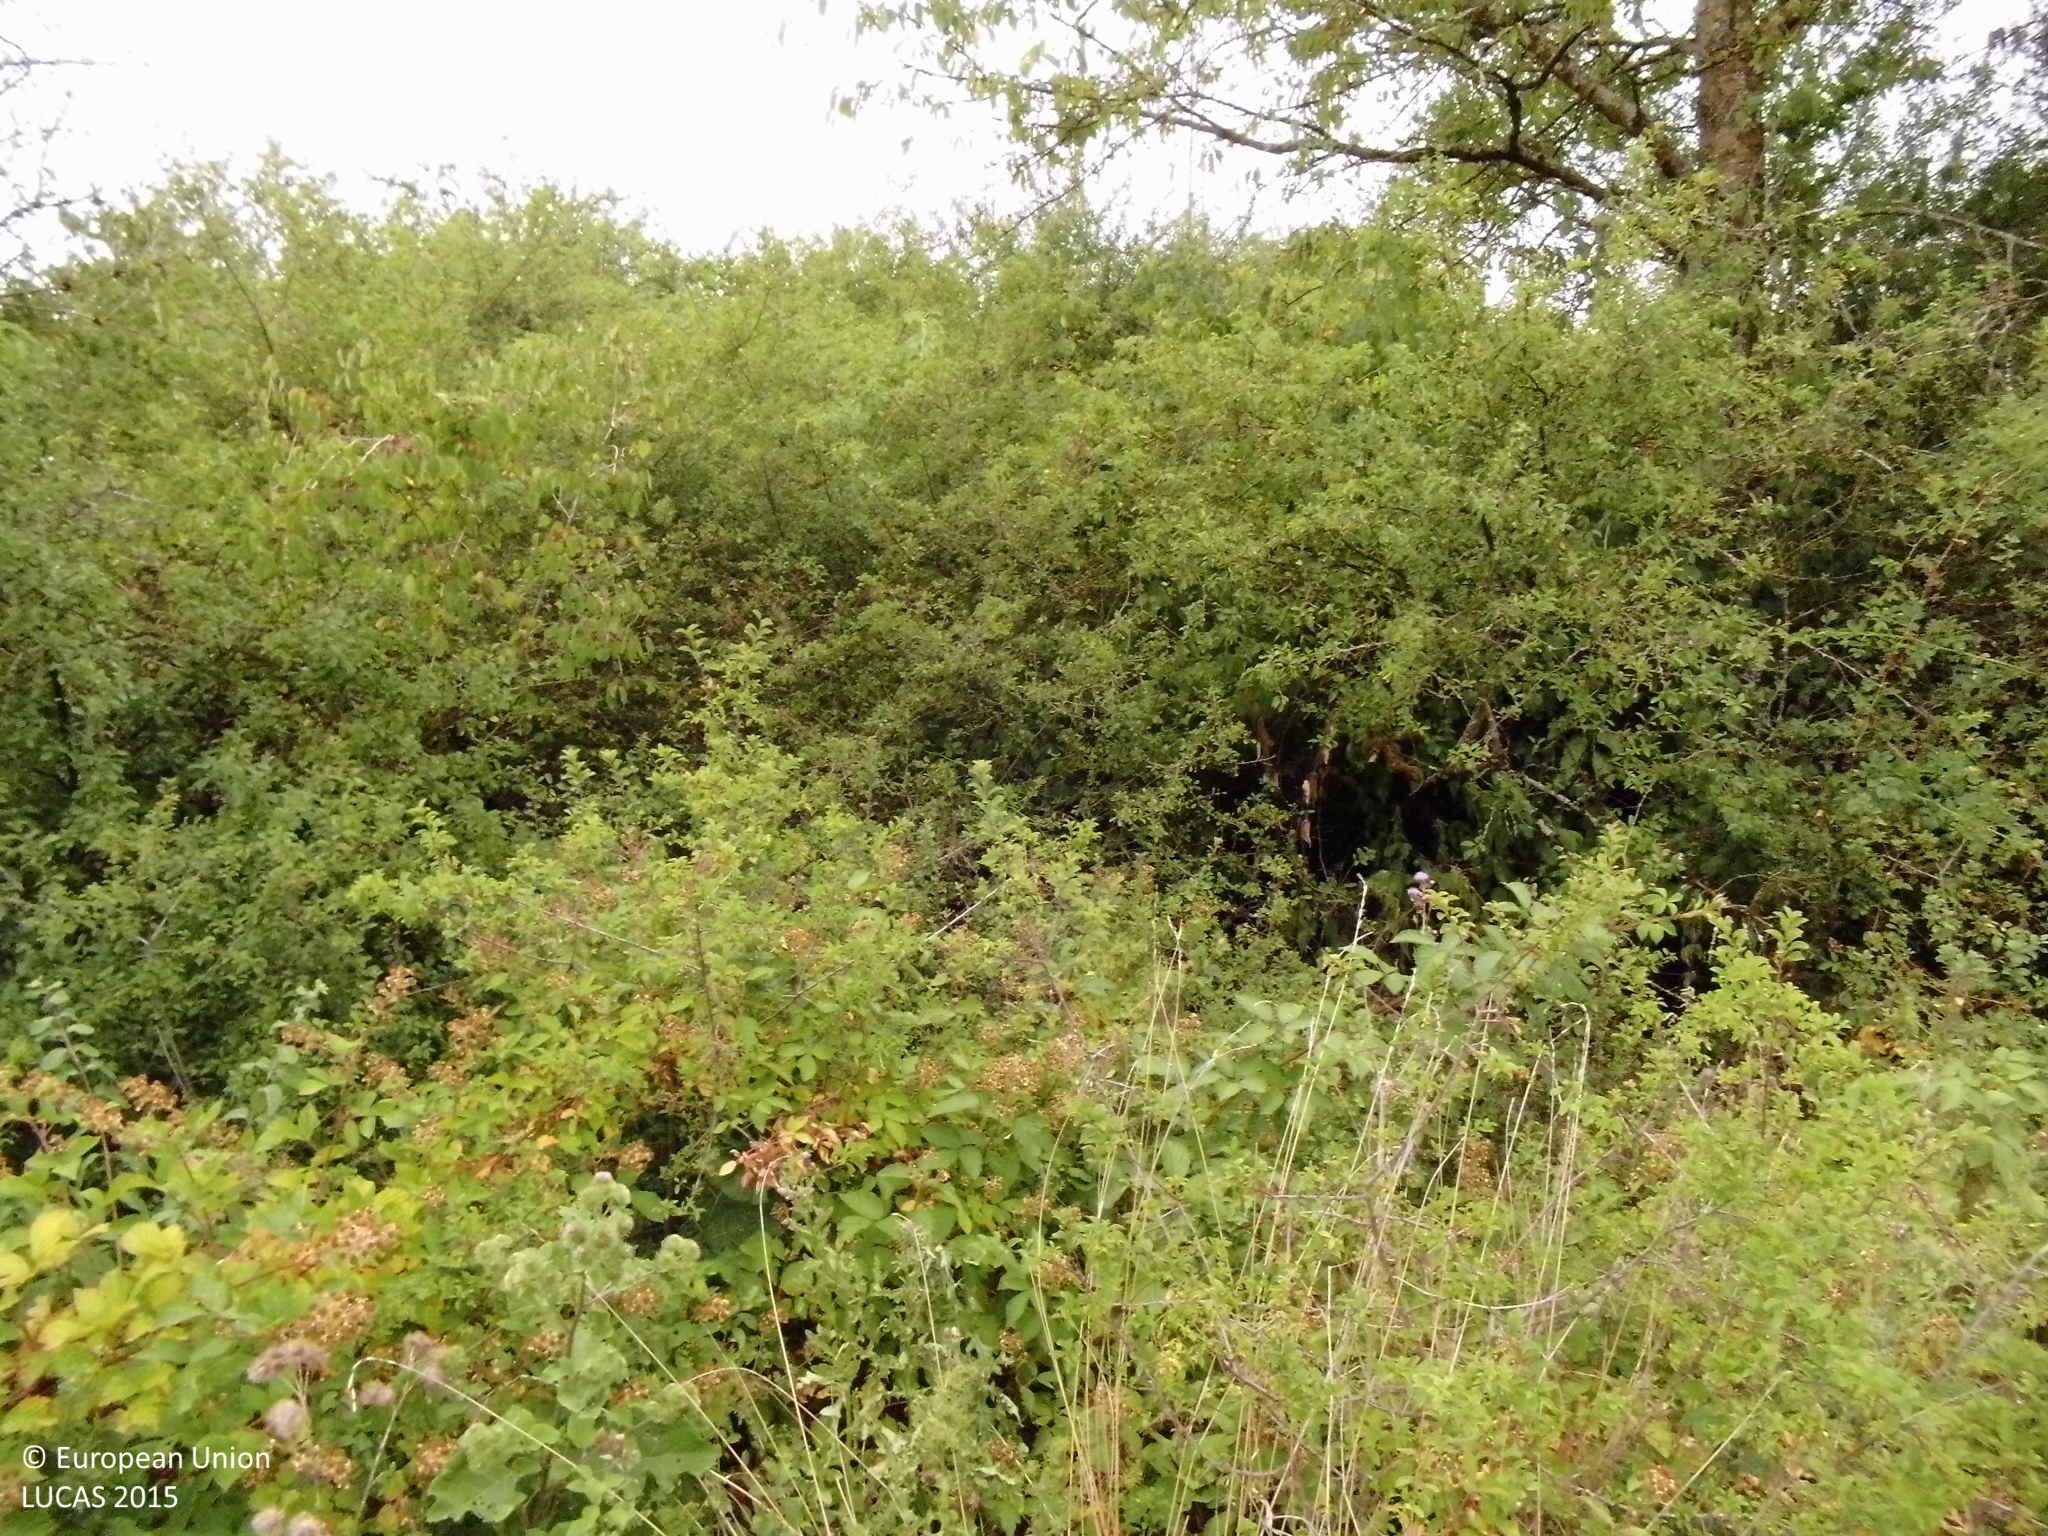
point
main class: Woodland
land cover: Broadleaved woodland
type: mesophytic deciduous forest
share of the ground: 50 - 75 %
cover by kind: broadleaved forest trees 60 %, shrubs 40 %
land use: Forestry
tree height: > 5 m
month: July
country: DE
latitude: 50.6055
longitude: 8.4602
